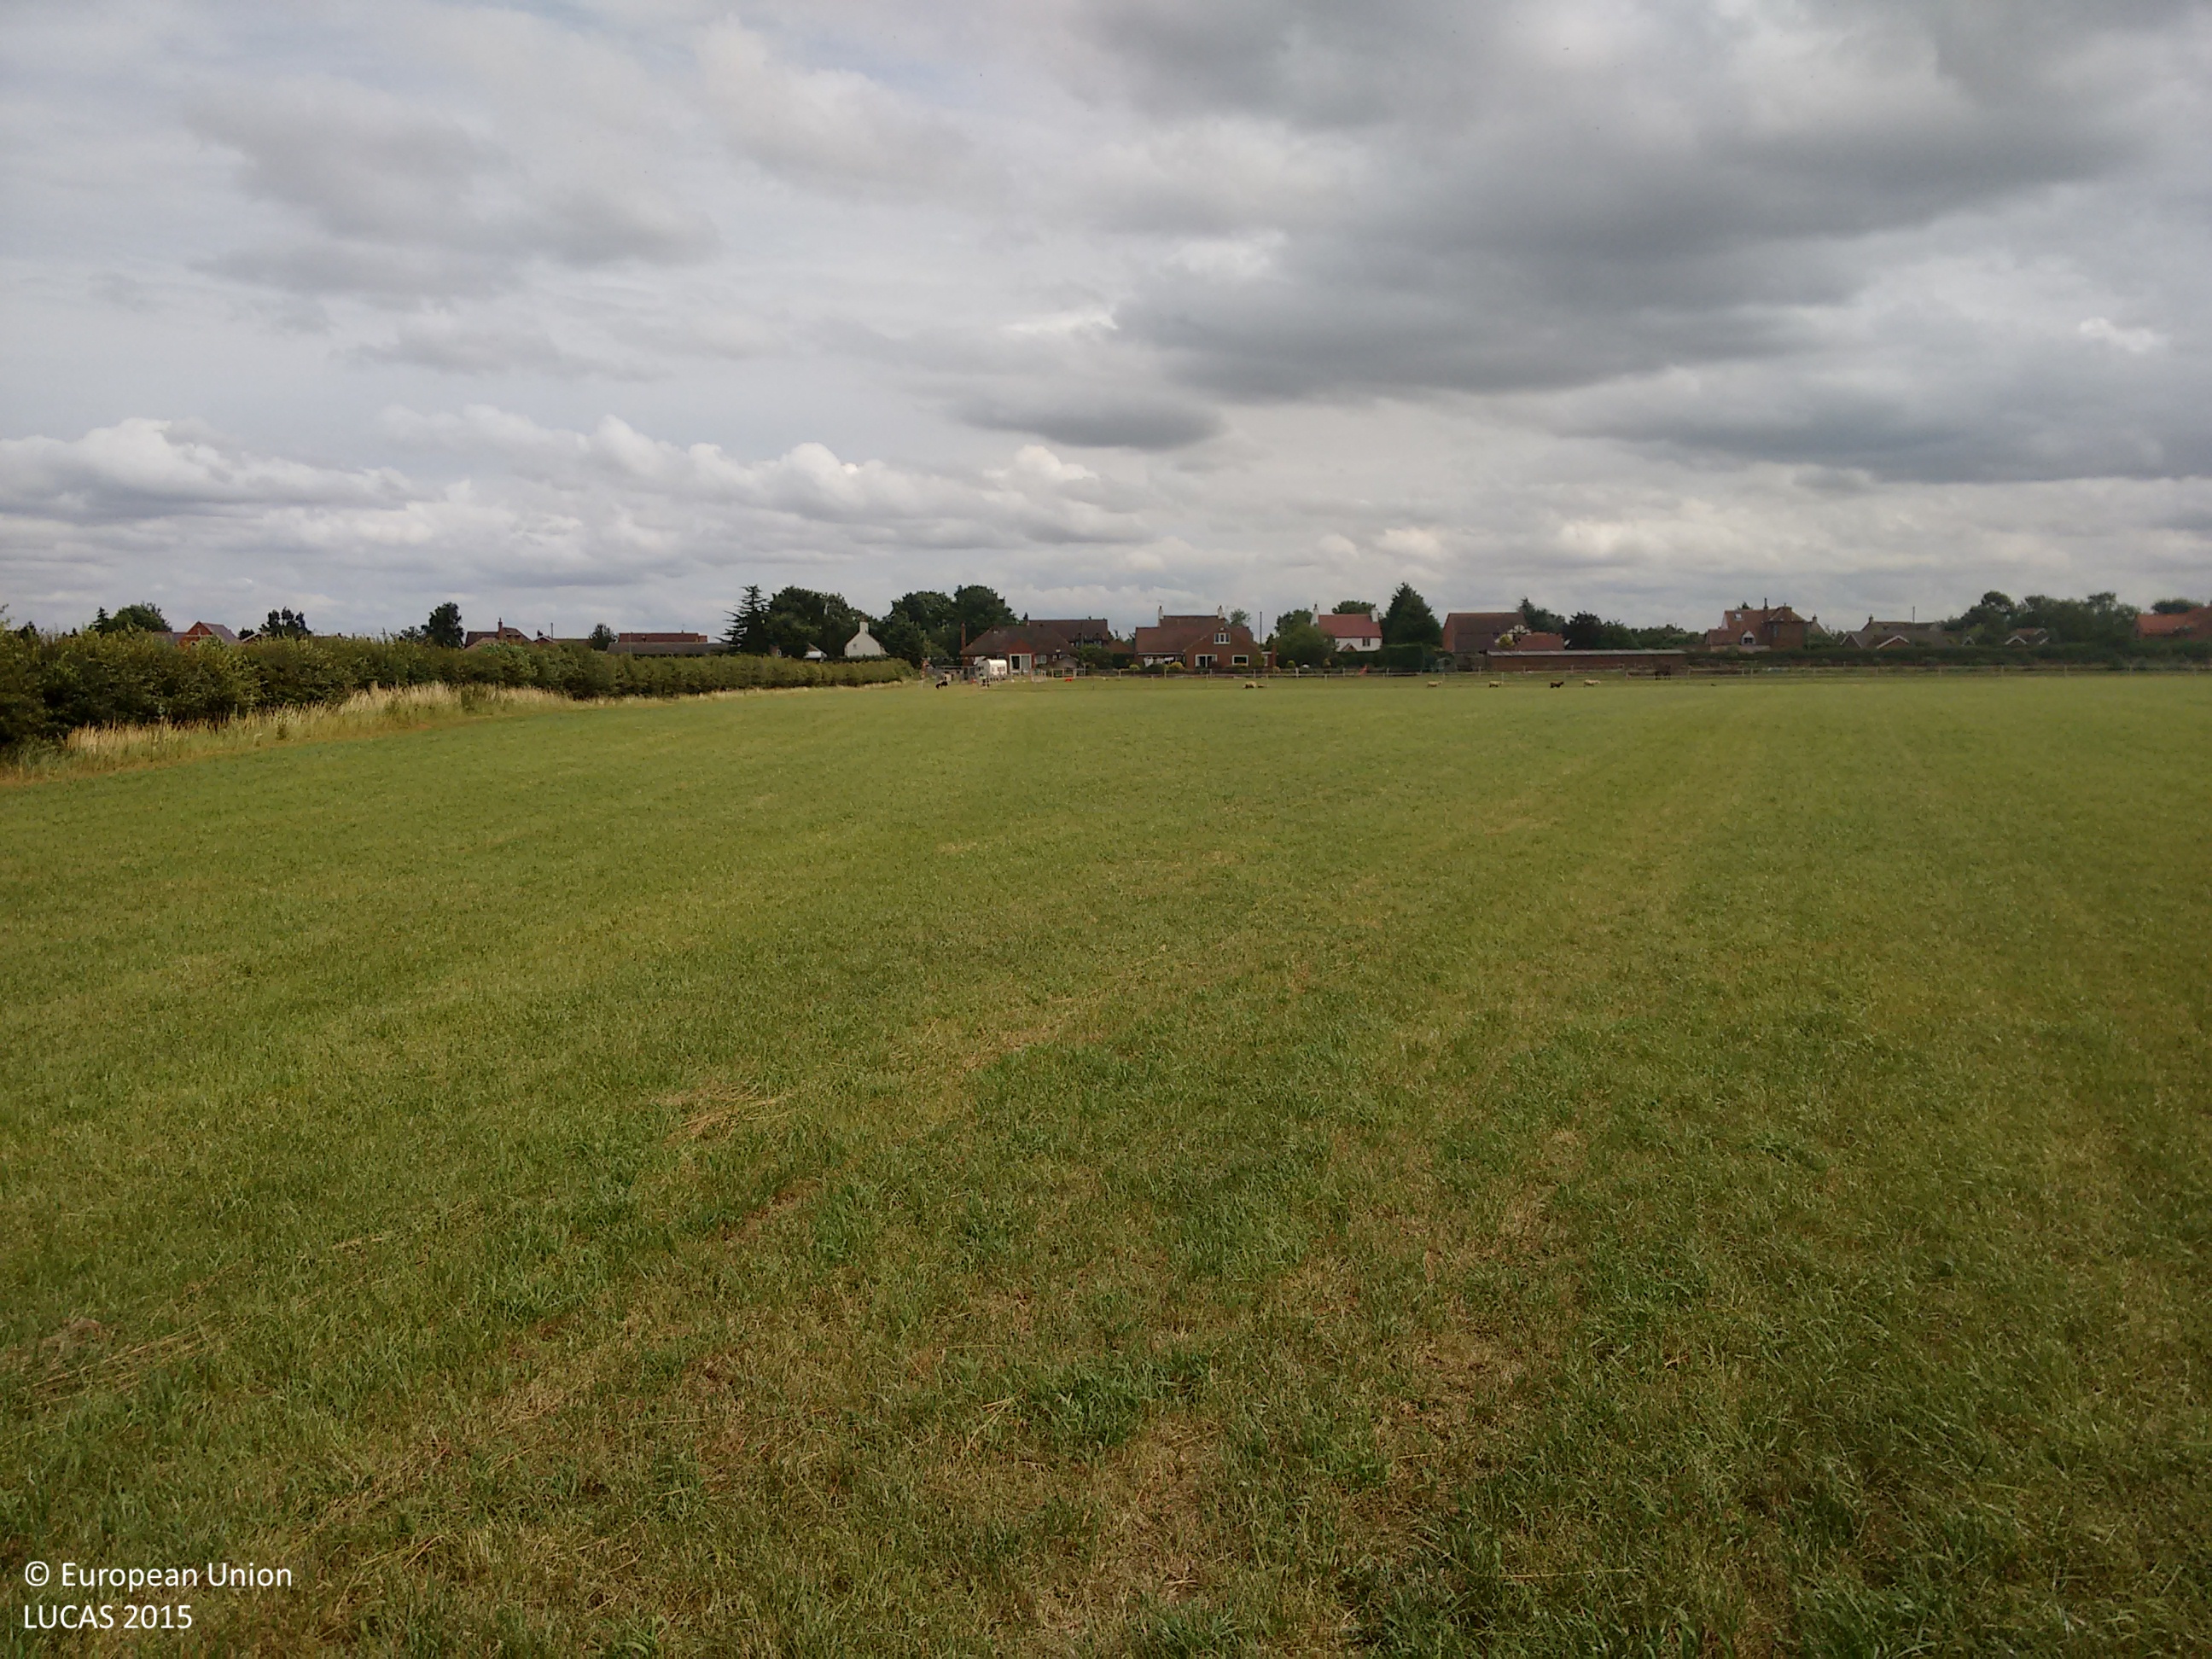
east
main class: Grassland
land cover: Grassland without tree/shrub cover
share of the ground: > 75 %
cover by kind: herbaceous plants 100 %
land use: Agriculture (excluding fallow land and kitchen gardens)
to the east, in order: Grassland without tree/shrub cover; Fences; Grassland without tree/shrub cover; Artificial constructions in urban areas
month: July
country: GB
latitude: 53.1158
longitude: -0.8136
